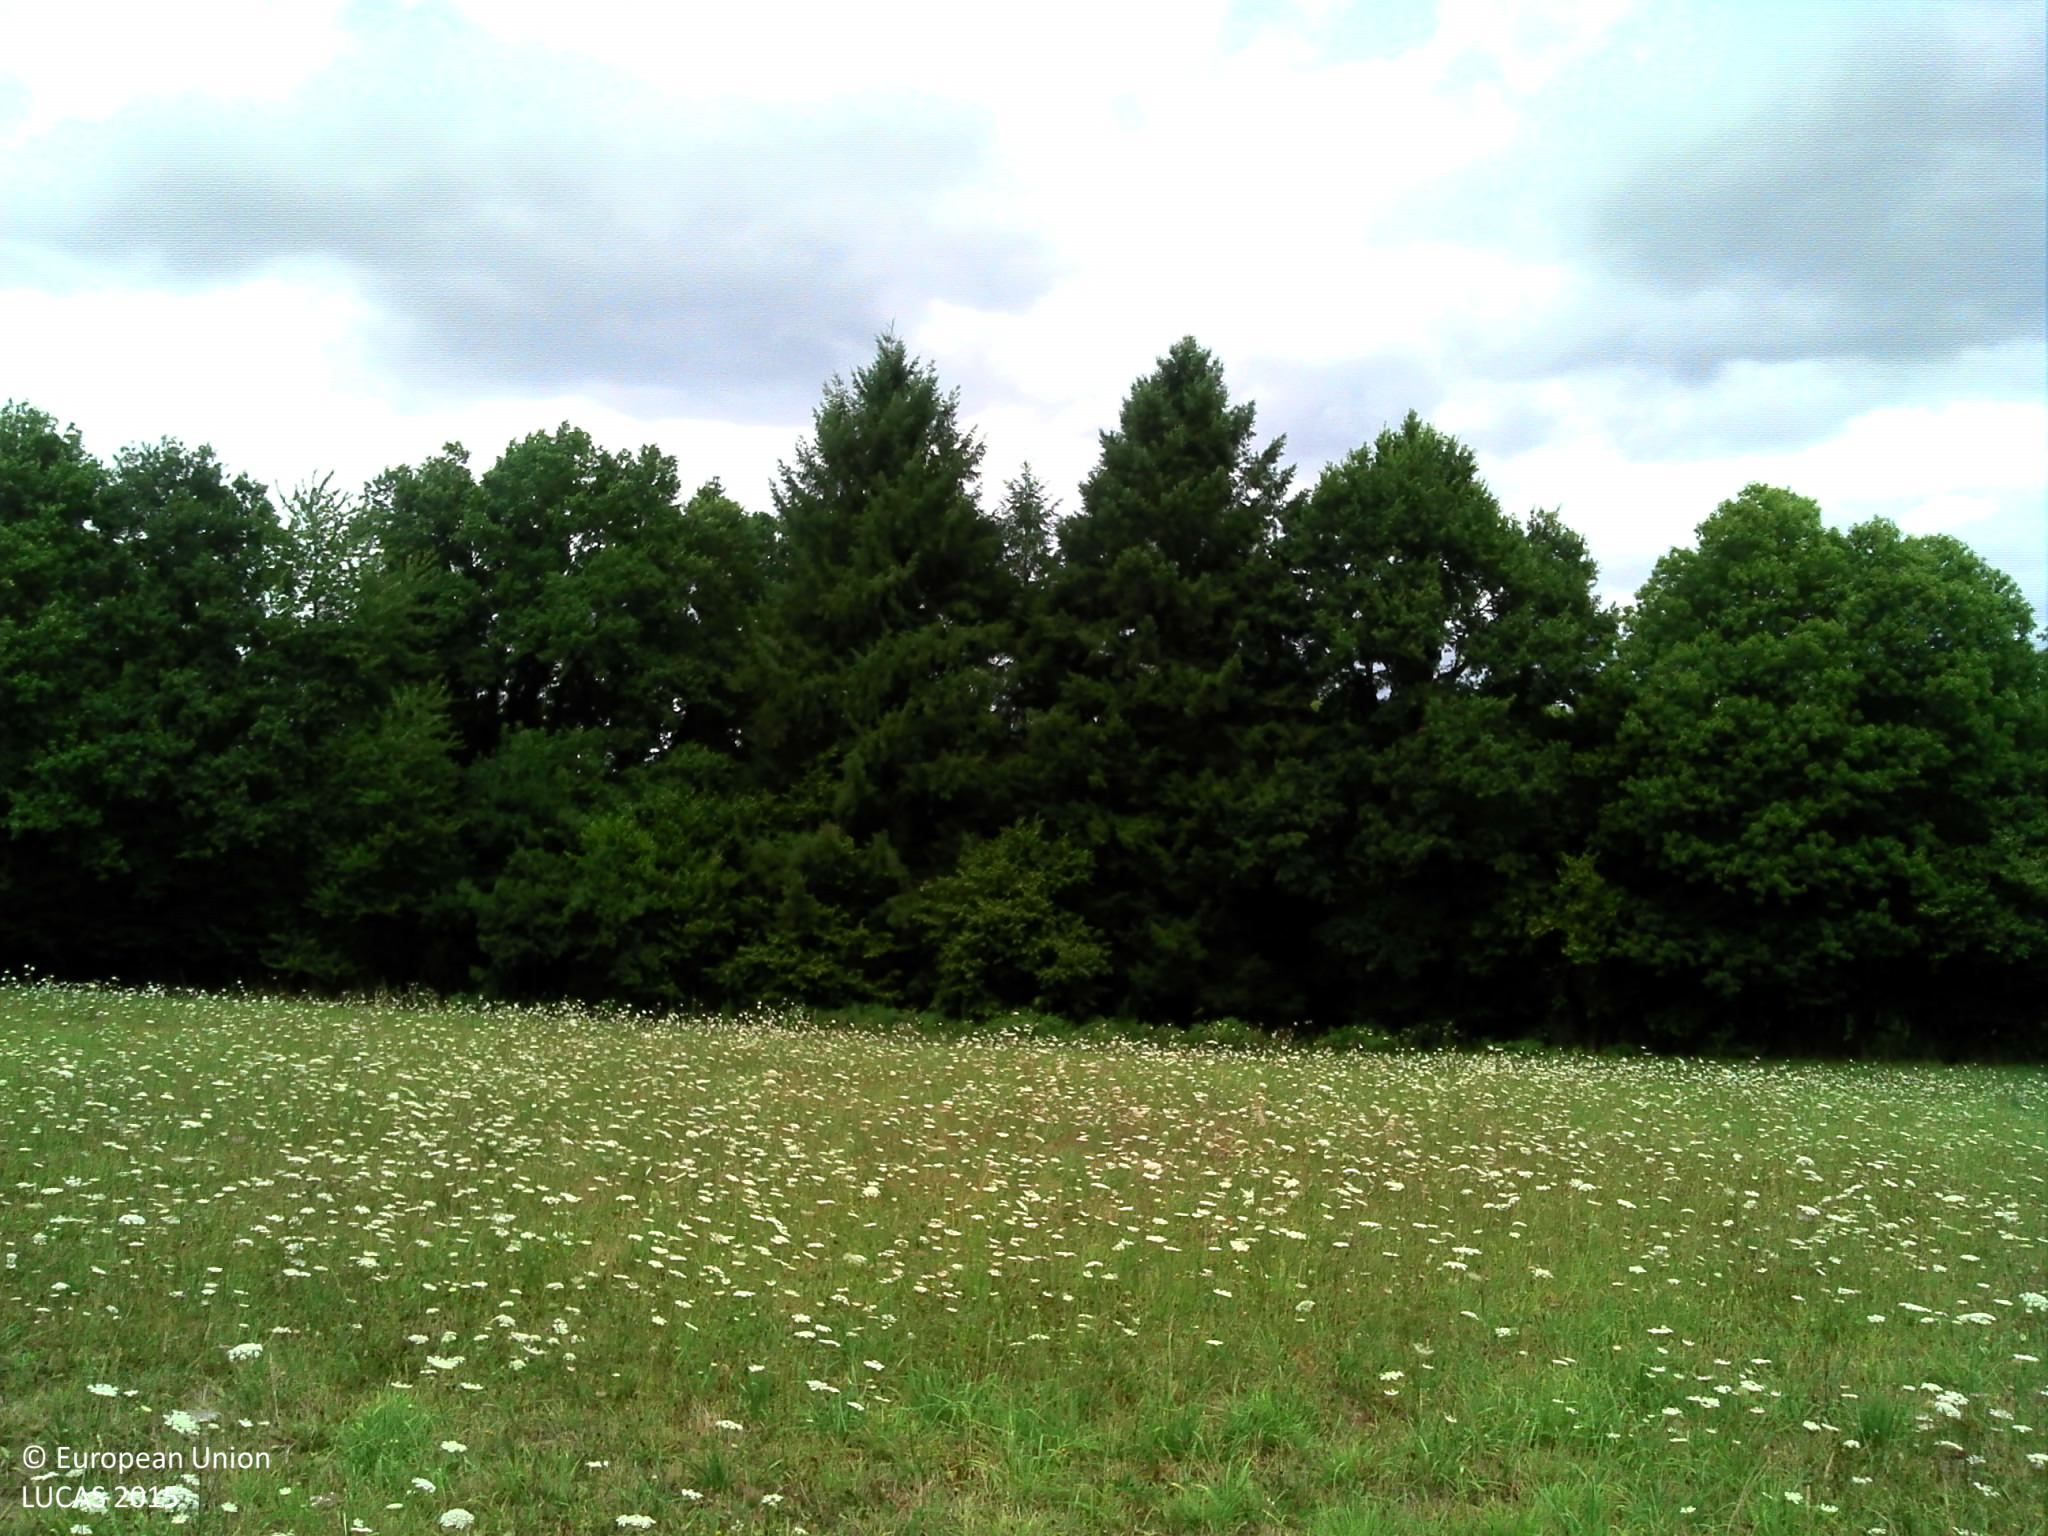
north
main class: Grassland
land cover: Grassland without tree/shrub cover
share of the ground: > 75 %
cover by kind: herbaceous plants 90 %, lichens and mosses 5 %, unconsolidated bare surface 5 %
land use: Agriculture (excluding fallow land and kitchen gardens)
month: July
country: FR
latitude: 45.6002
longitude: 0.6932
